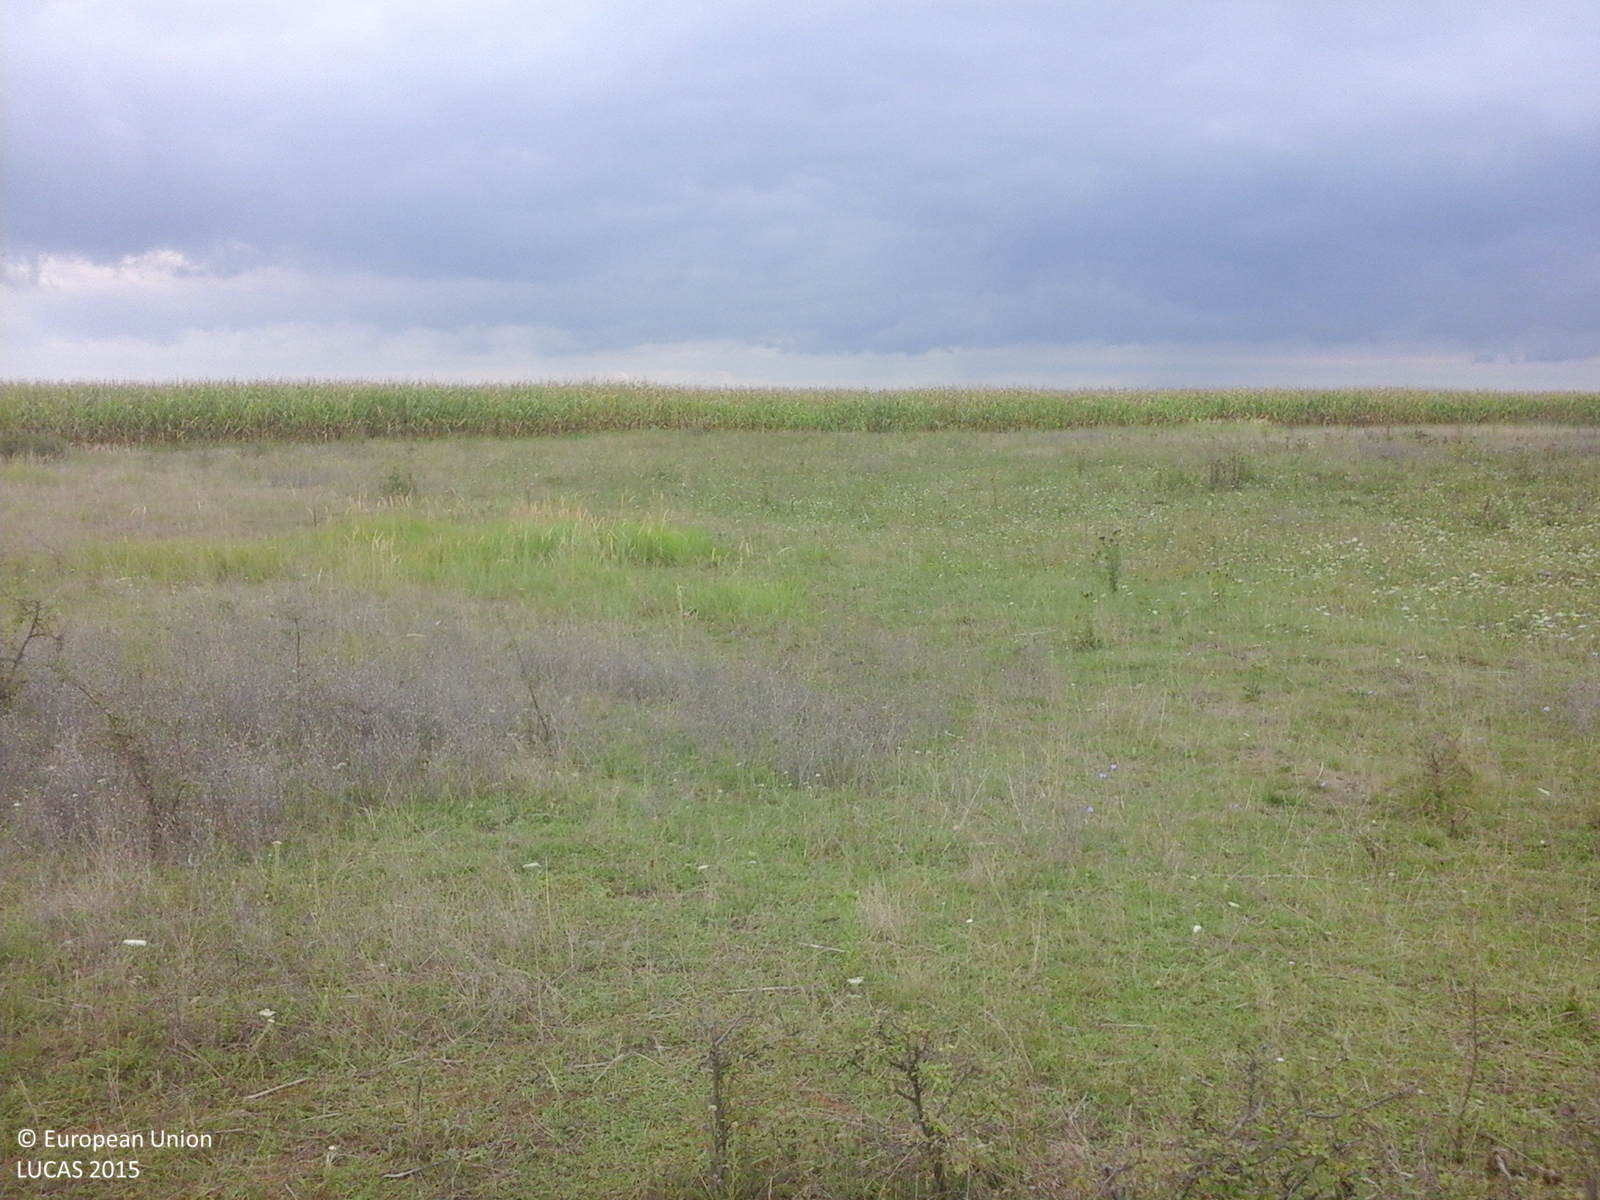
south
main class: Grassland
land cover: Grassland with sparse tree/shrub cover
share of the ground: > 75 %
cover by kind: herbaceous plants 85 %, shrubs 10 %, broadleaved forest trees 5 %
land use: Agriculture (excluding fallow land and kitchen gardens)
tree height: < 5 m
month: August
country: RO
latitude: 45.5019
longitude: 21.0722
